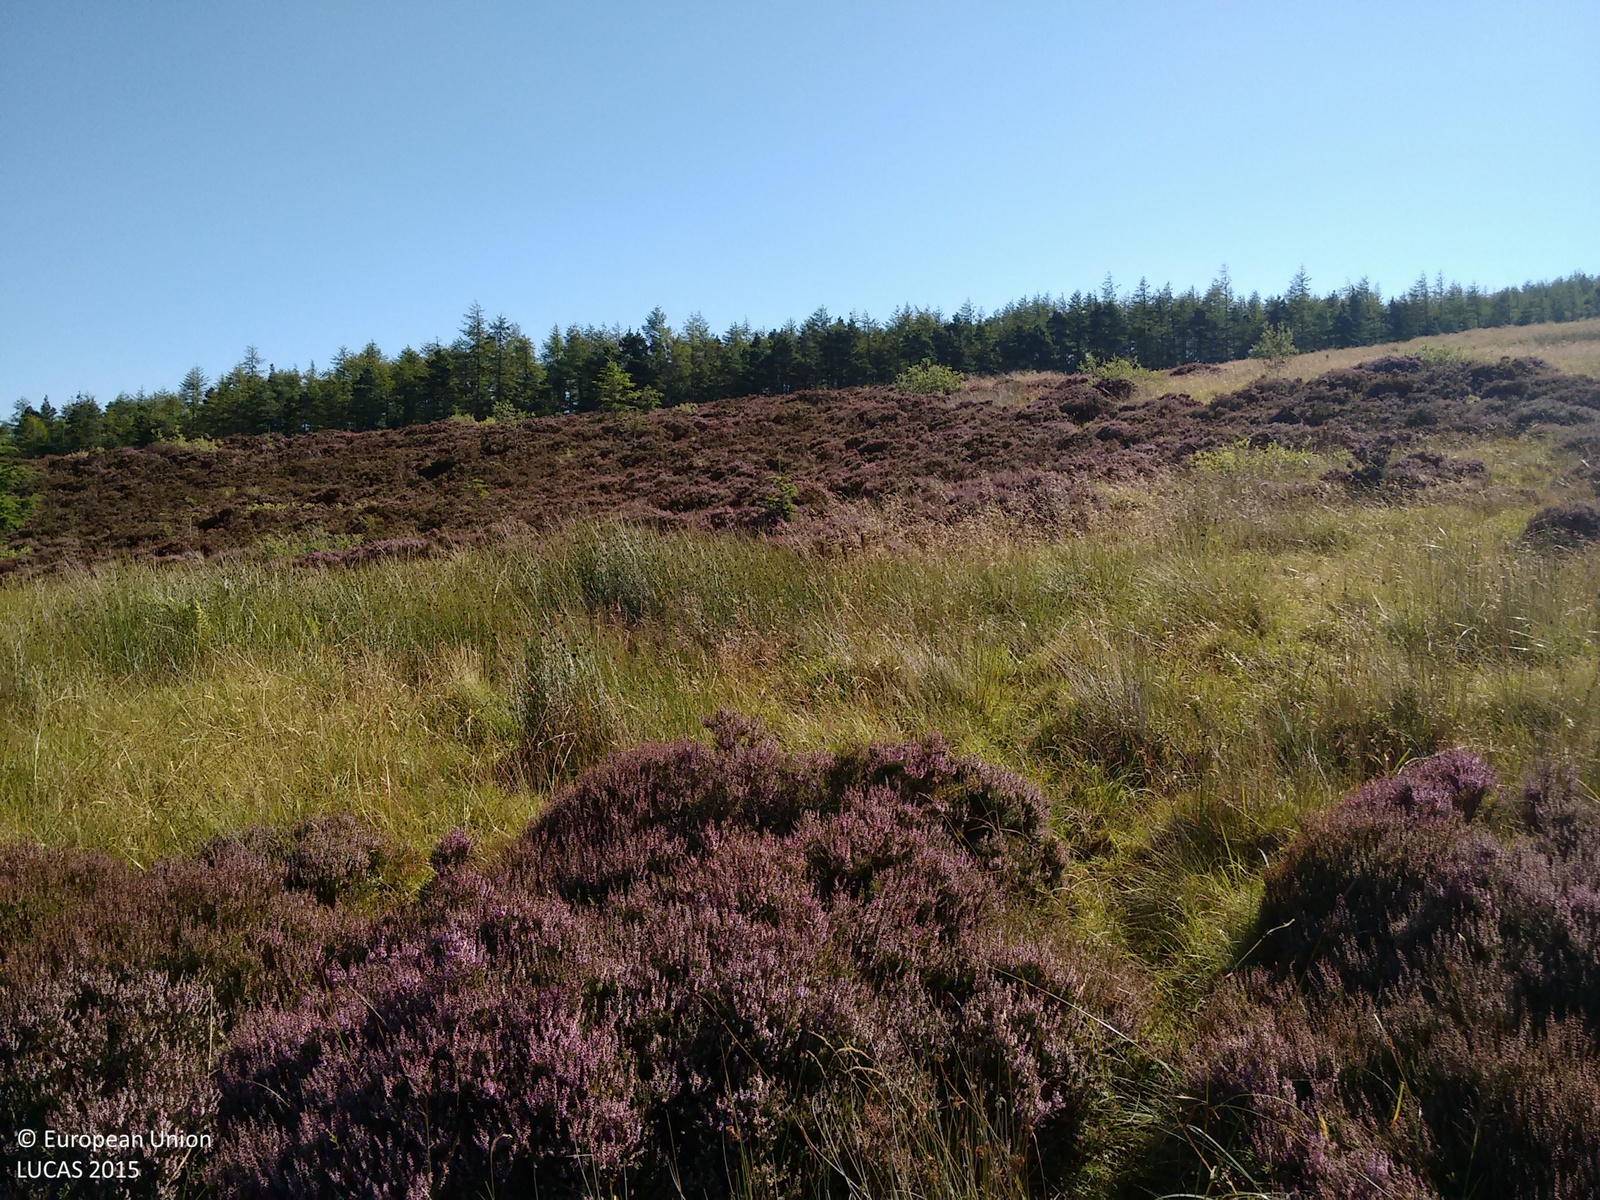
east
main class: Shrubland
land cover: Shrubland without tree cover
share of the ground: > 75 %
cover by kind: shrubs 55 %, herbaceous plants 45 %
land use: Agriculture (excluding fallow land and kitchen gardens)
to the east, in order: Shrubland without tree cover; Fences; Grassland without tree/shrub cover; Fences; Pine dominated coniferous woodland
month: August
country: GB
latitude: 57.5261
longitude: -3.0369
